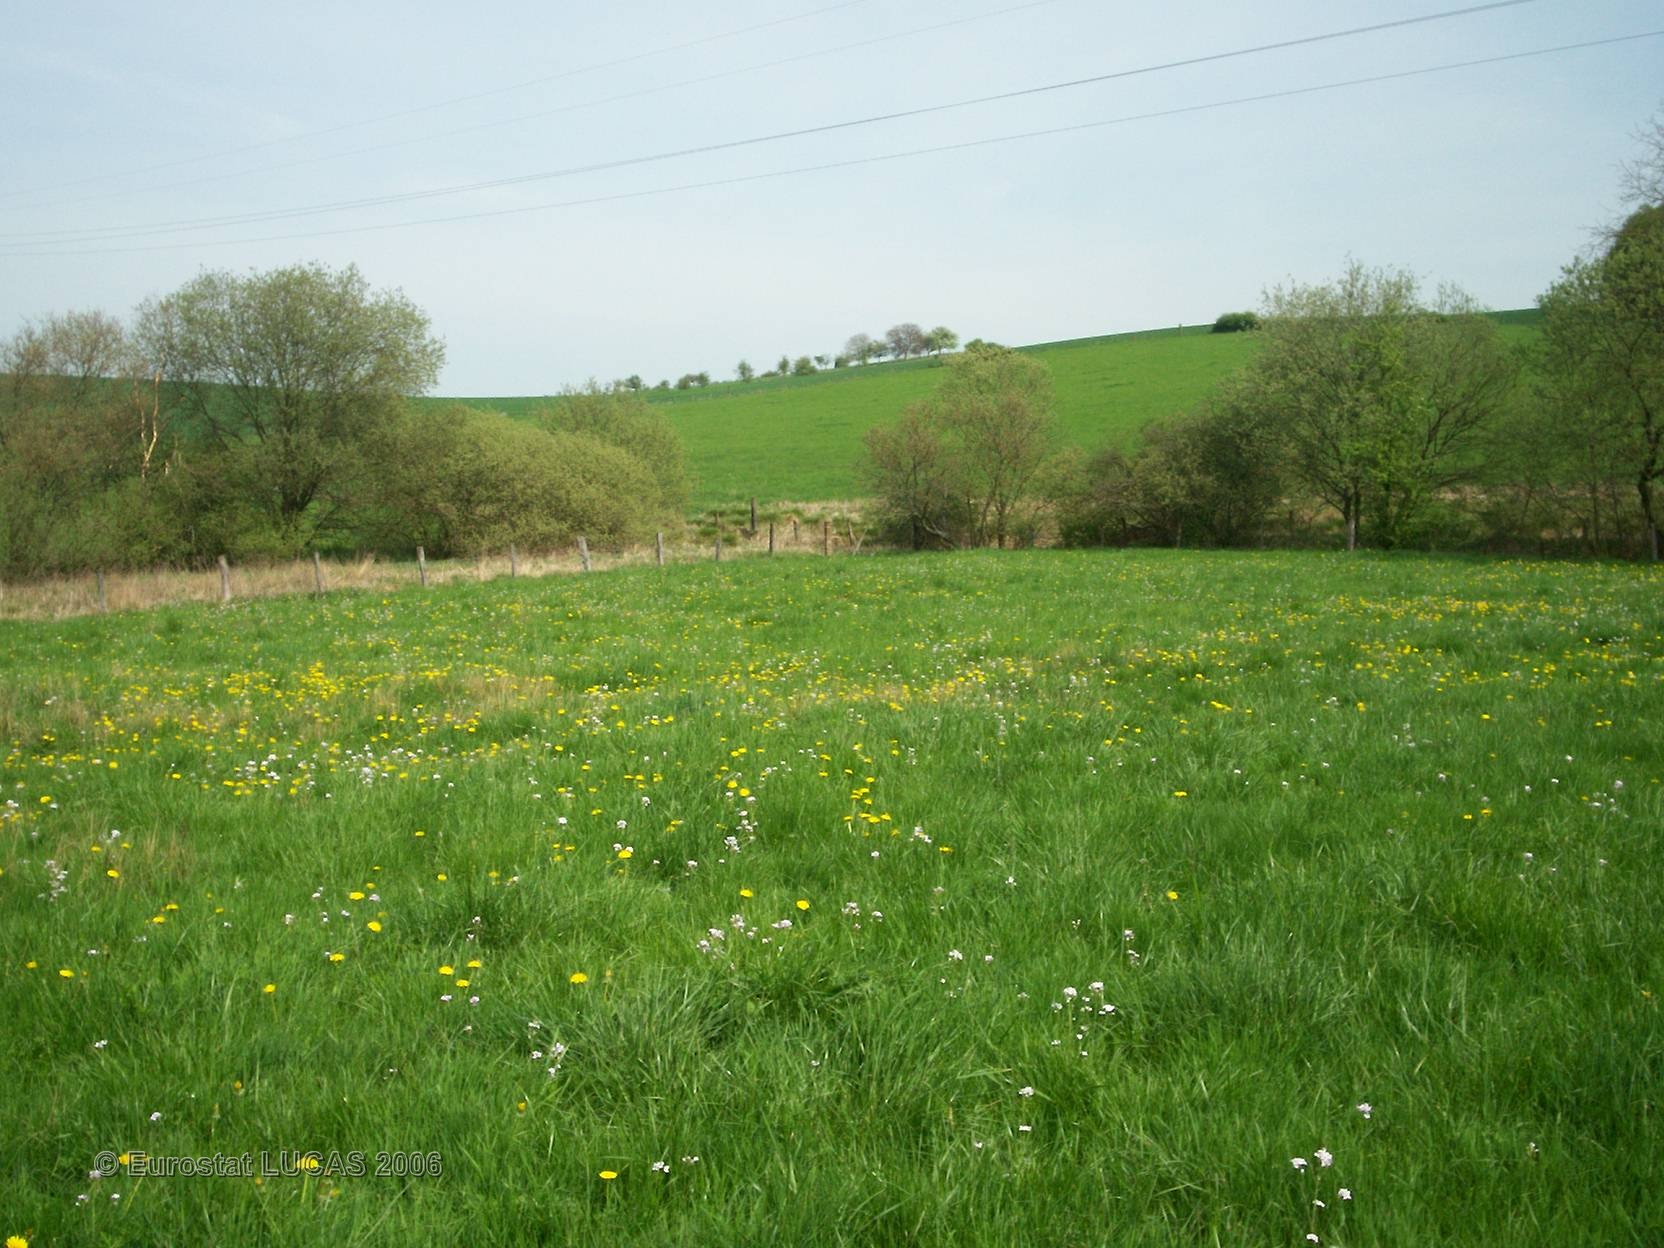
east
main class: Grassland
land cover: Grassland without tree/shrub cover
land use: Agriculture (excluding fallow land and kitchen gardens)
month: May
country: FR
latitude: 49.0650
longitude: 7.0030
